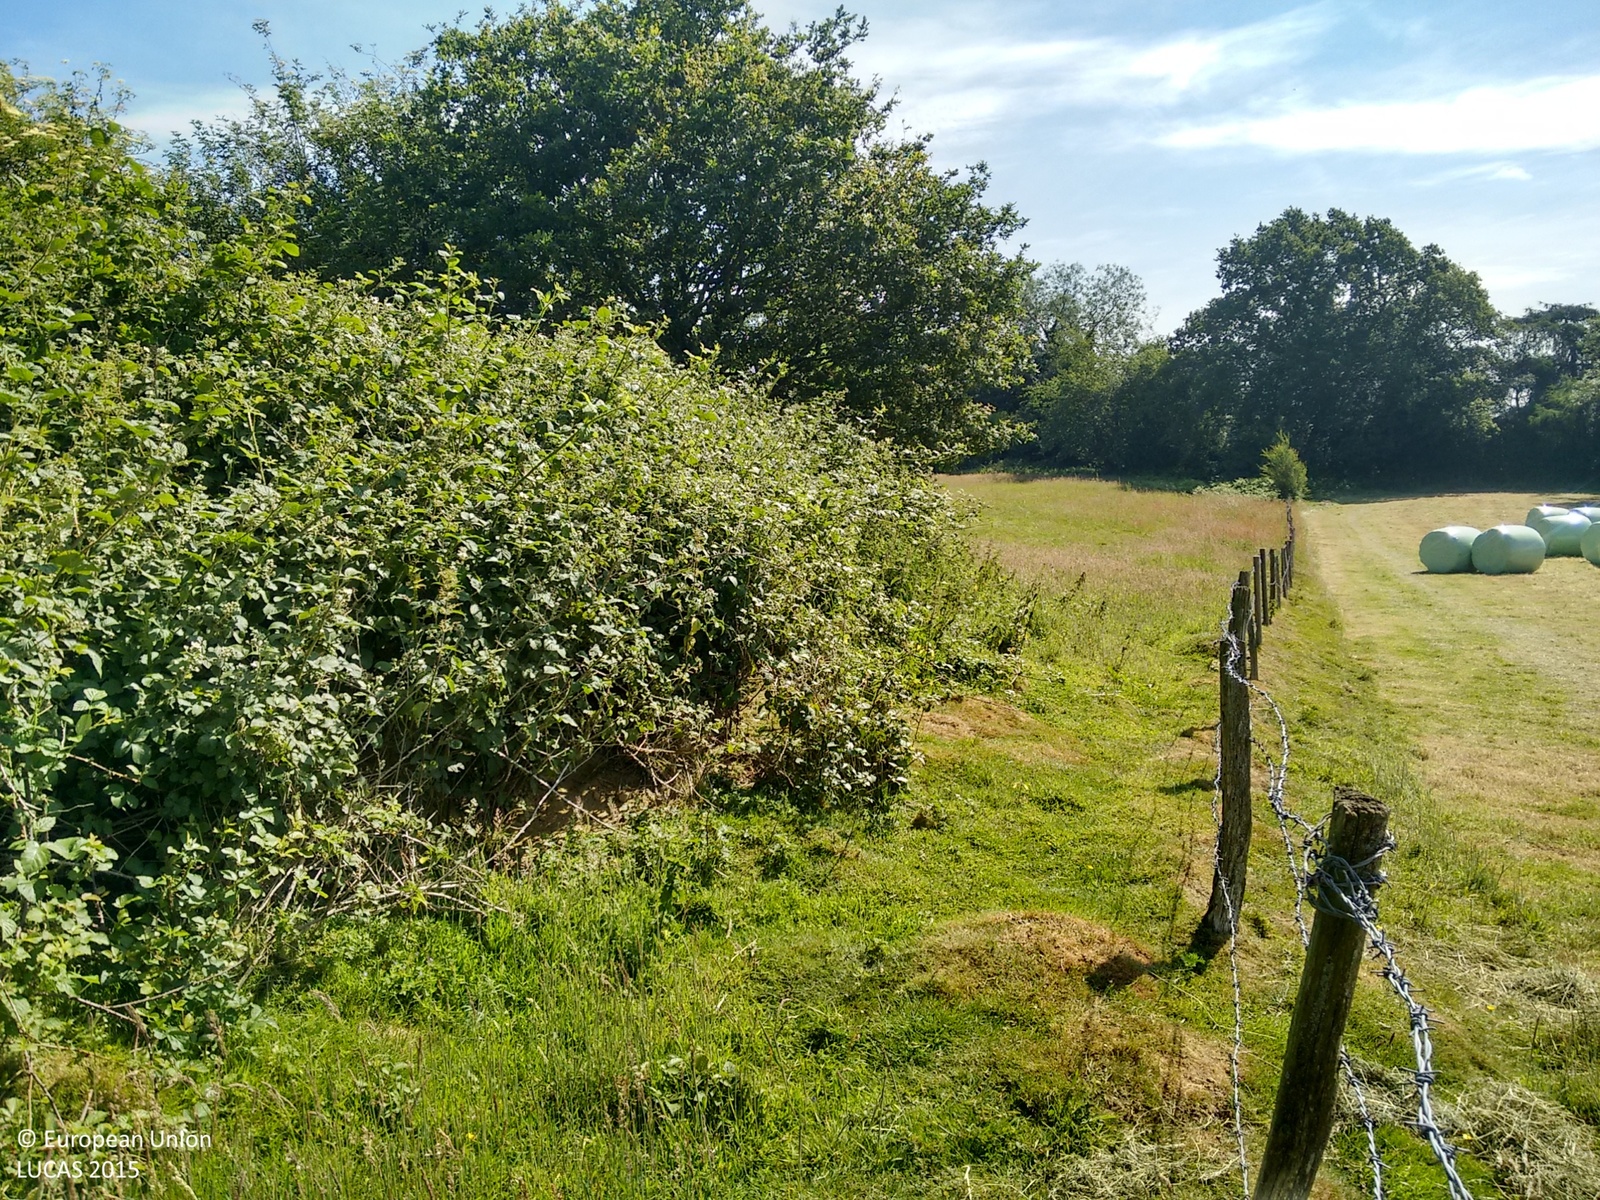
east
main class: Grassland
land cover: Grassland without tree/shrub cover
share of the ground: > 75 %
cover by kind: herbaceous plants 100 %
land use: Agriculture (excluding fallow land and kitchen gardens)
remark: Harvested field
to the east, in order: Grassland without tree/shrub cover; Fences; Broadleaved woodland; Tracks; Broadleaved woodland; Fences; Grassland without tree/shrub cover
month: June
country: GB
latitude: 51.1141
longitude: -0.0759
